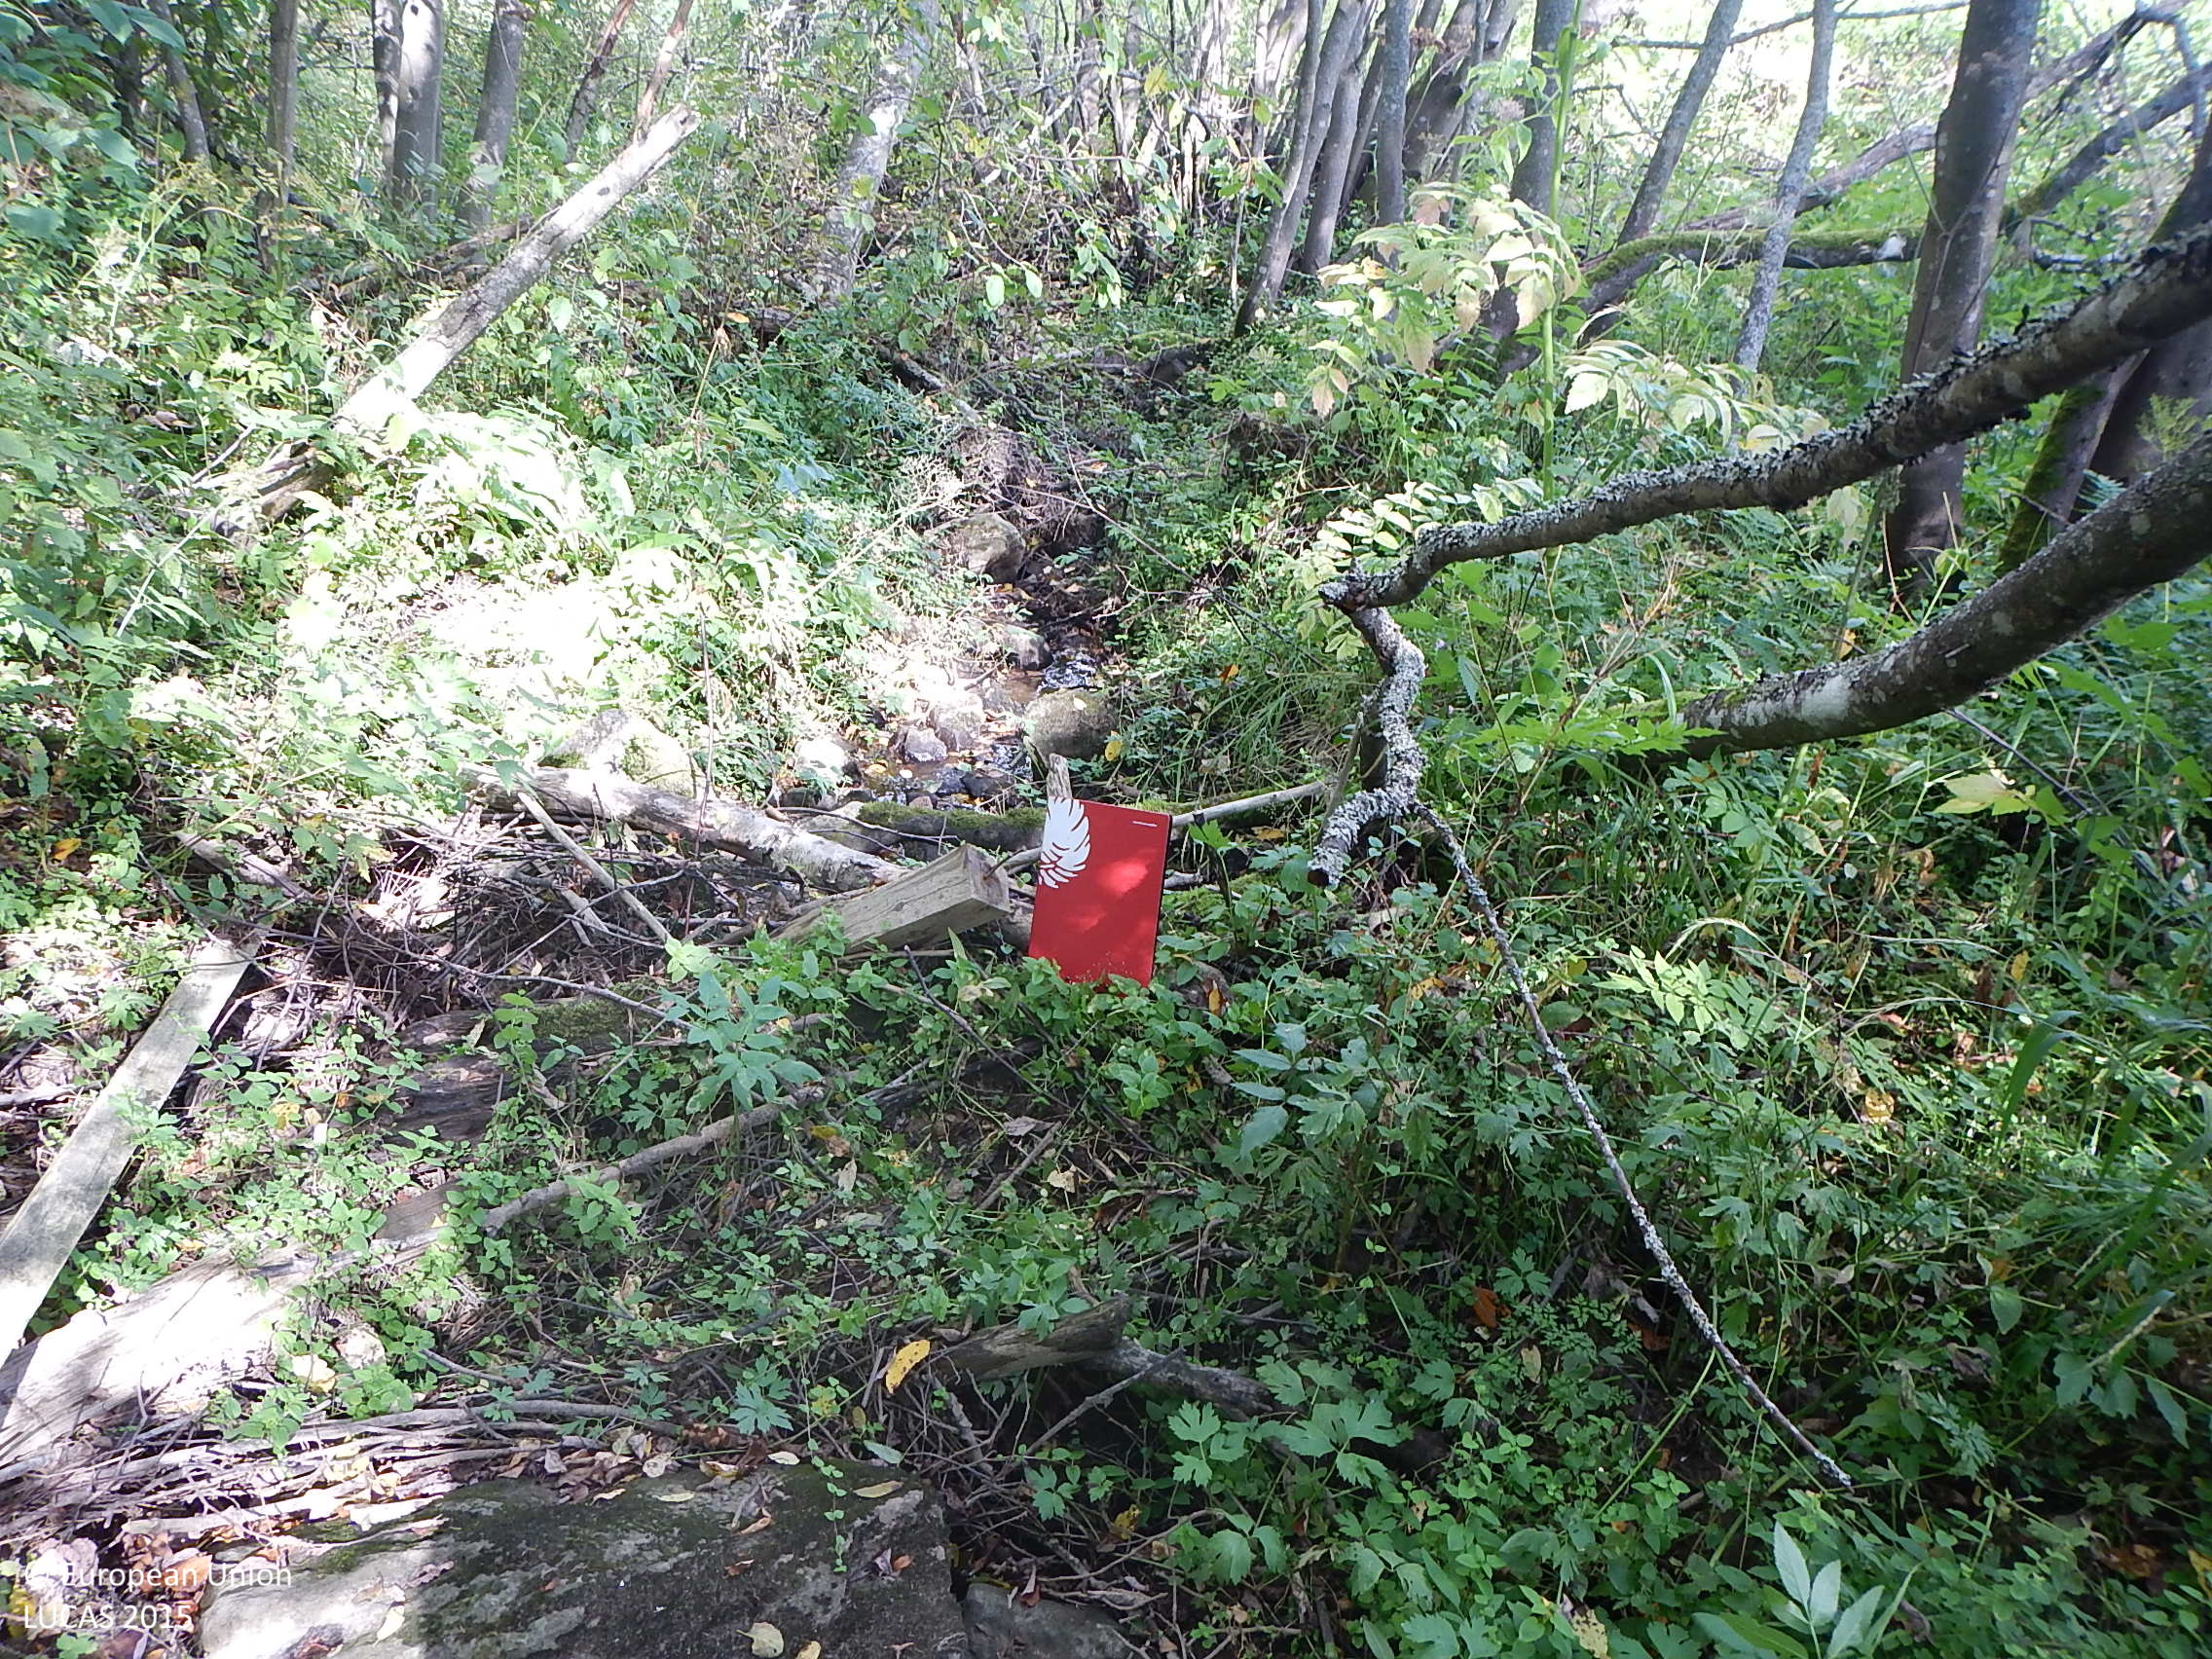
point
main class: Woodland
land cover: Broadleaved woodland
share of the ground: > 75 %
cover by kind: broadleaved forest trees 90 %, shrubs 10 %
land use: Semi-natural and natural areas not in use
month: September
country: FI
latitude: 61.4541
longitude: 22.0065
